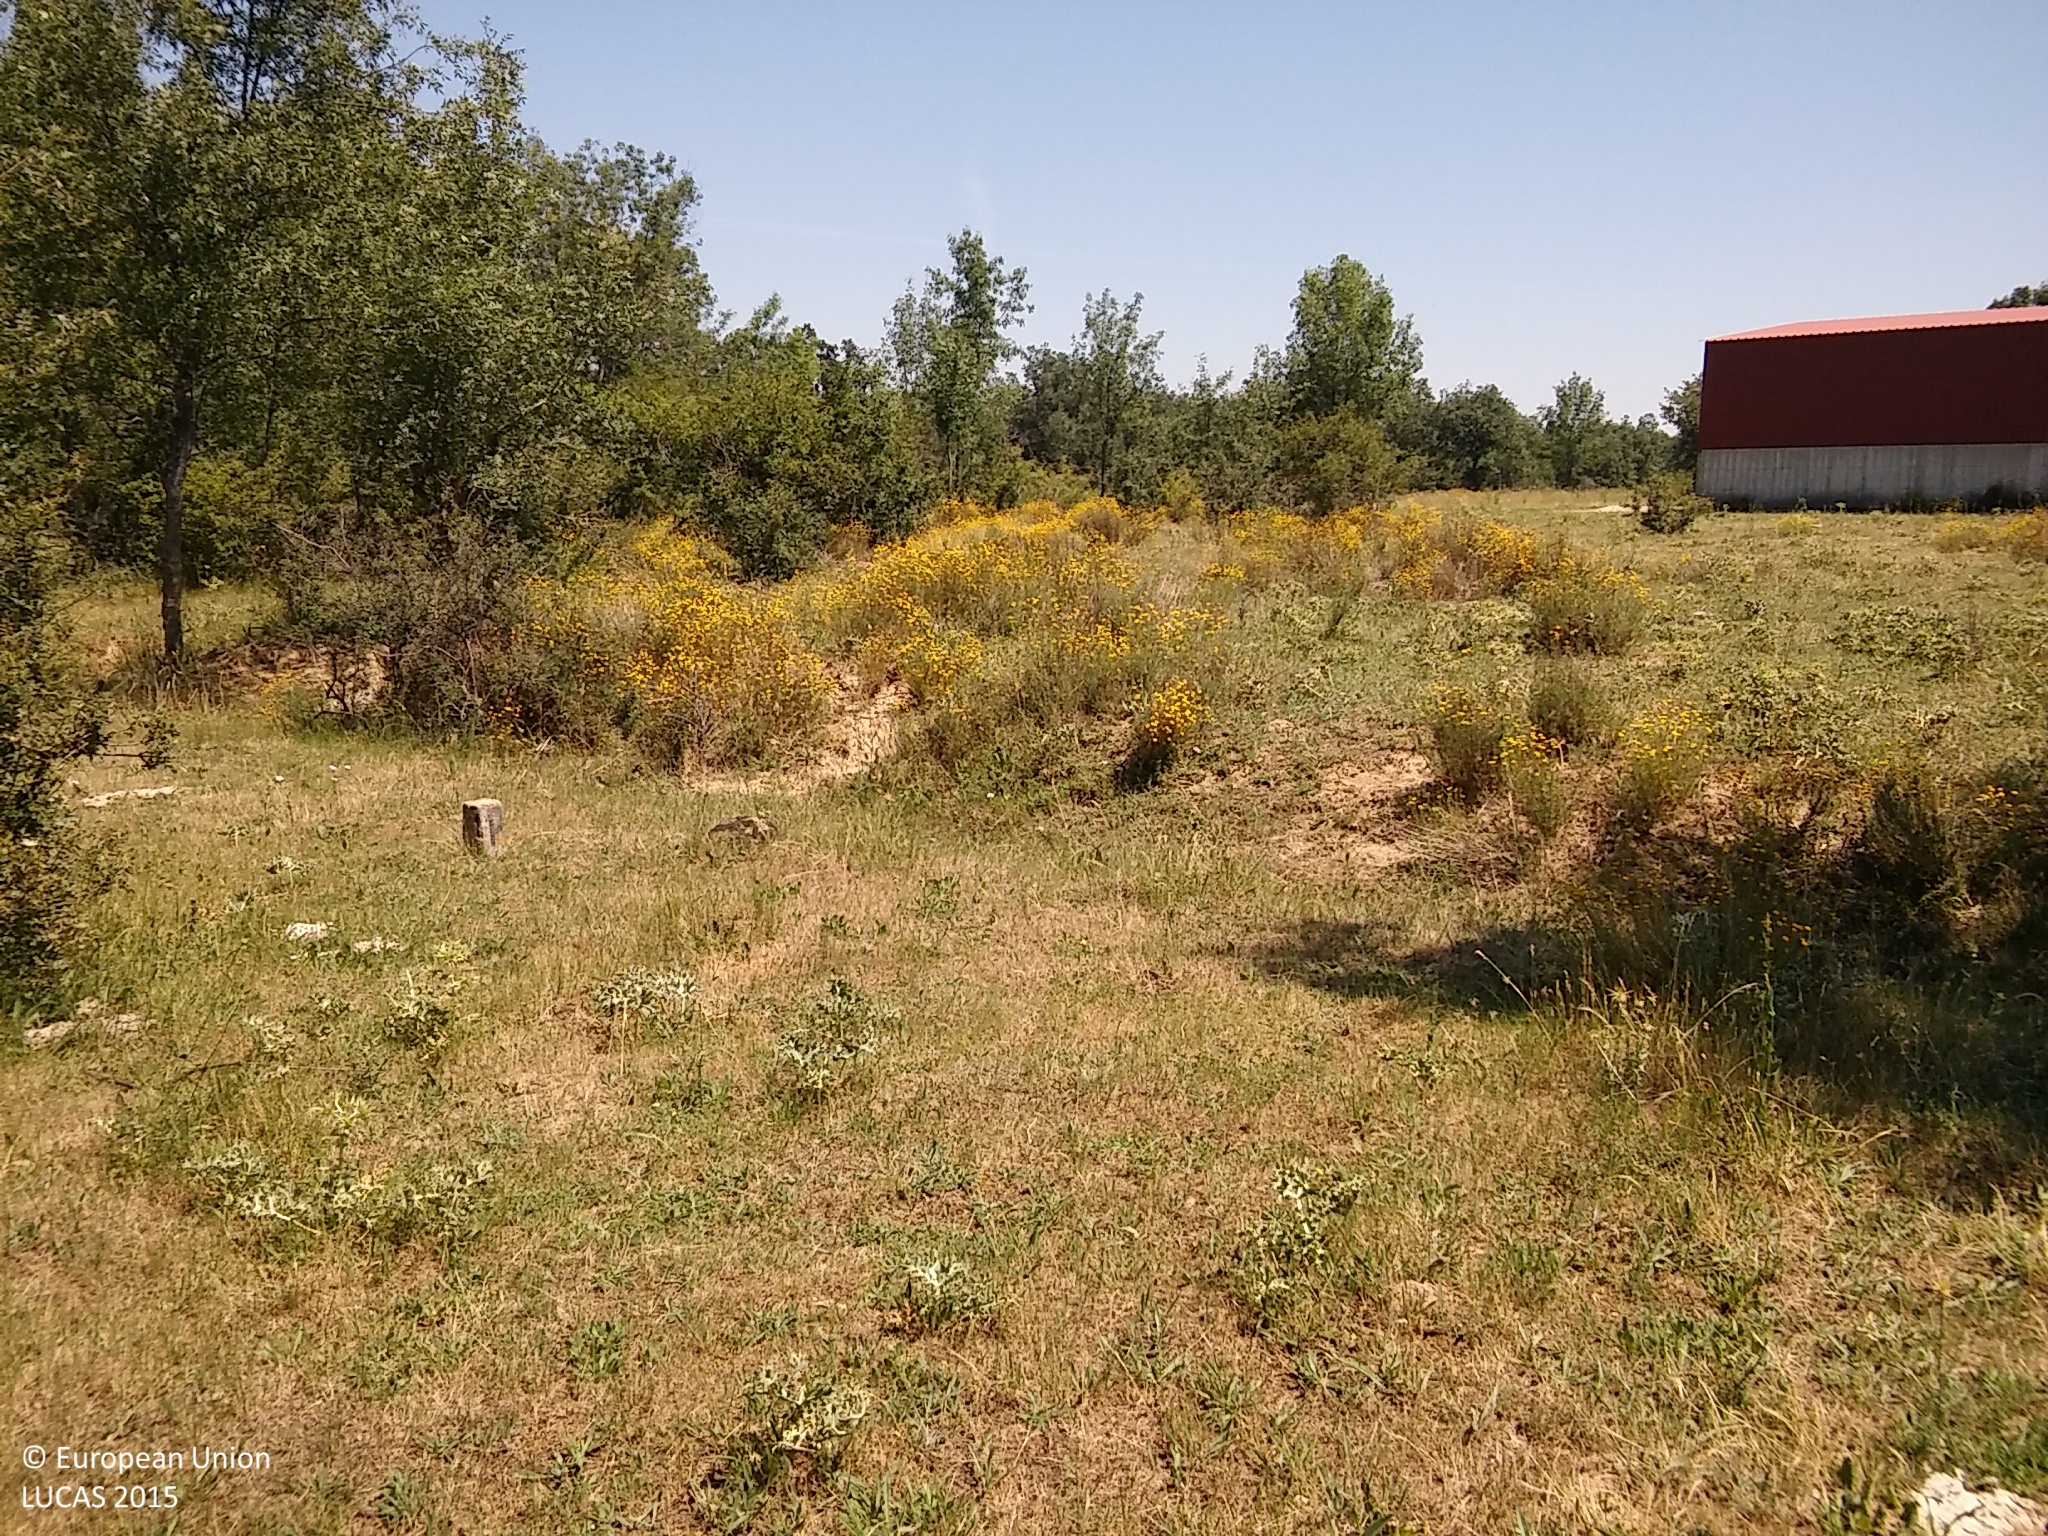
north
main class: Woodland
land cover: Broadleaved woodland
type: broadleaved evergreen forest
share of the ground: 10 - 25 %
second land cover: Grassland without tree/shrub cover
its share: 50 - 75 %
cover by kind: herbaceous plants 75 %, broadleaved forest trees 15 %, shrubs 10 %
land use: Forestry
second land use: Agriculture (excluding fallow land and kitchen gardens)
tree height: > 5 m
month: June
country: ES
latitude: 41.0418
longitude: -3.9555
